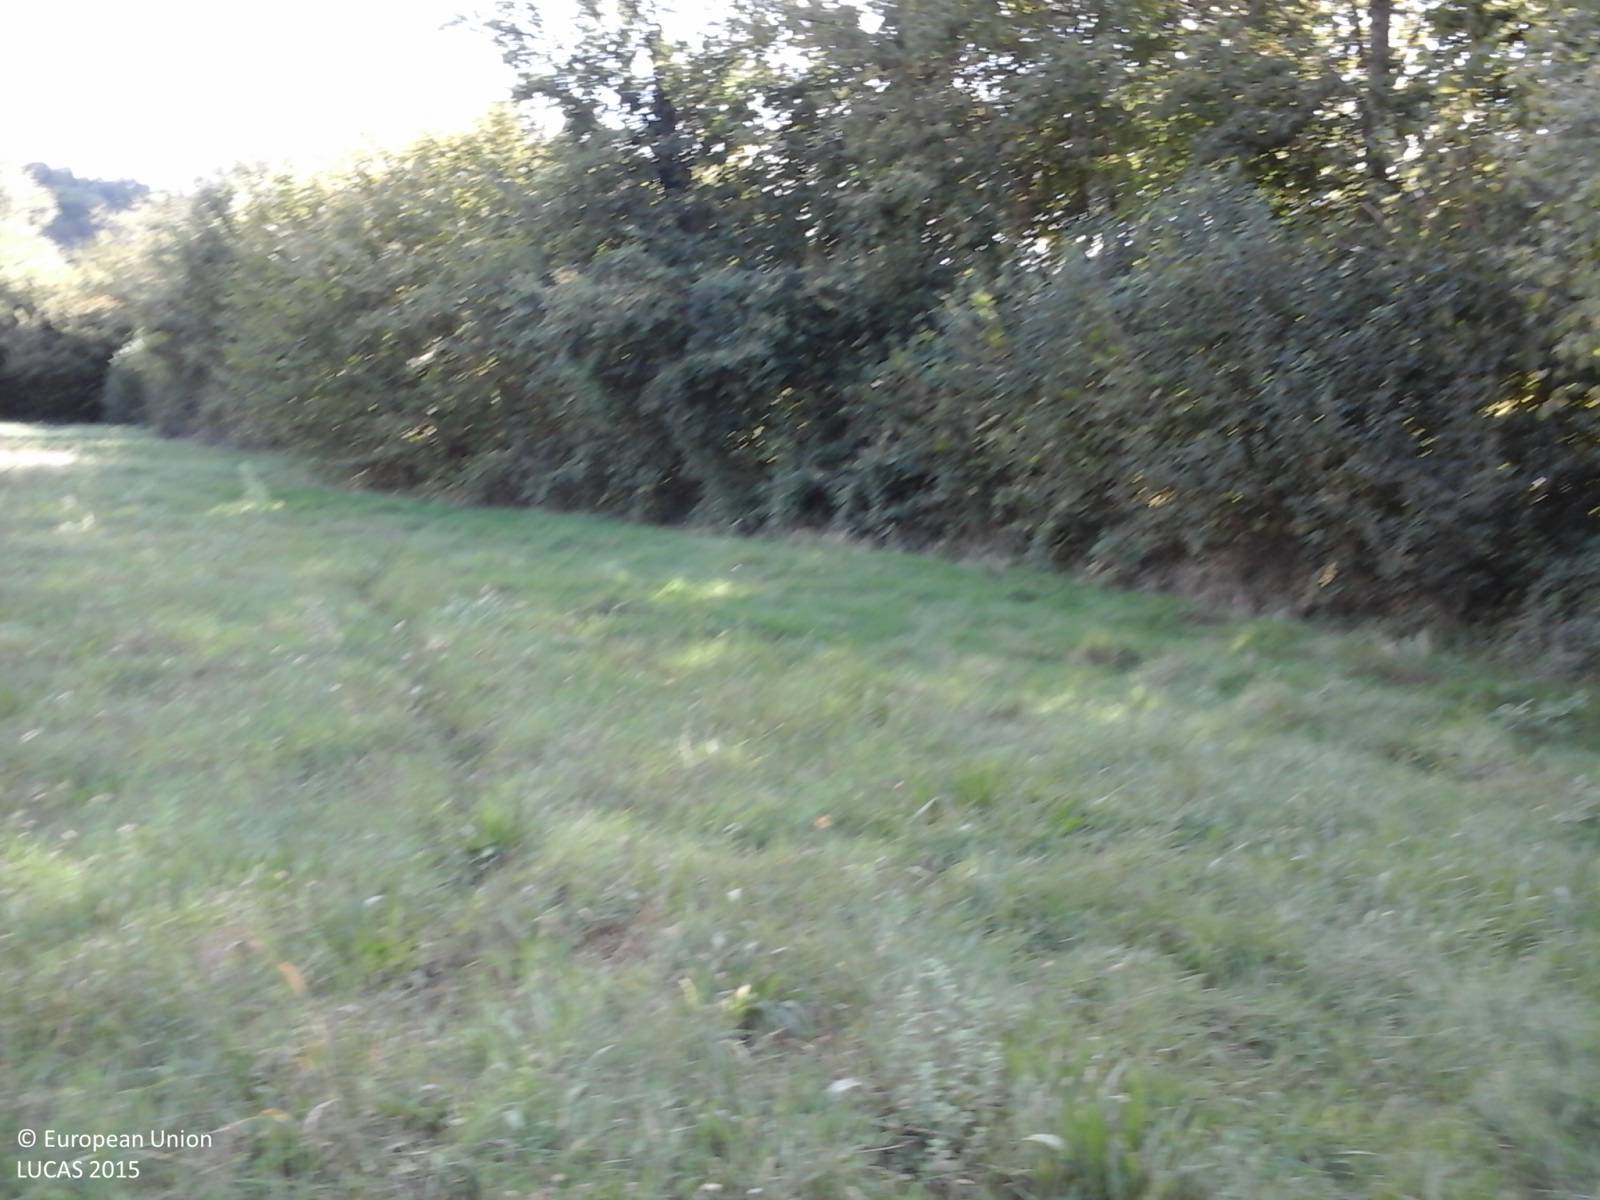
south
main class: Woodland
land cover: Broadleaved woodland
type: thermophilous deciduous forest
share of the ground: > 75 %
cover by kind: broadleaved forest trees 85 %, shrubs 15 %
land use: Forestry
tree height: > 5 m
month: October
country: IT
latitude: 42.3062
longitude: 12.8654
